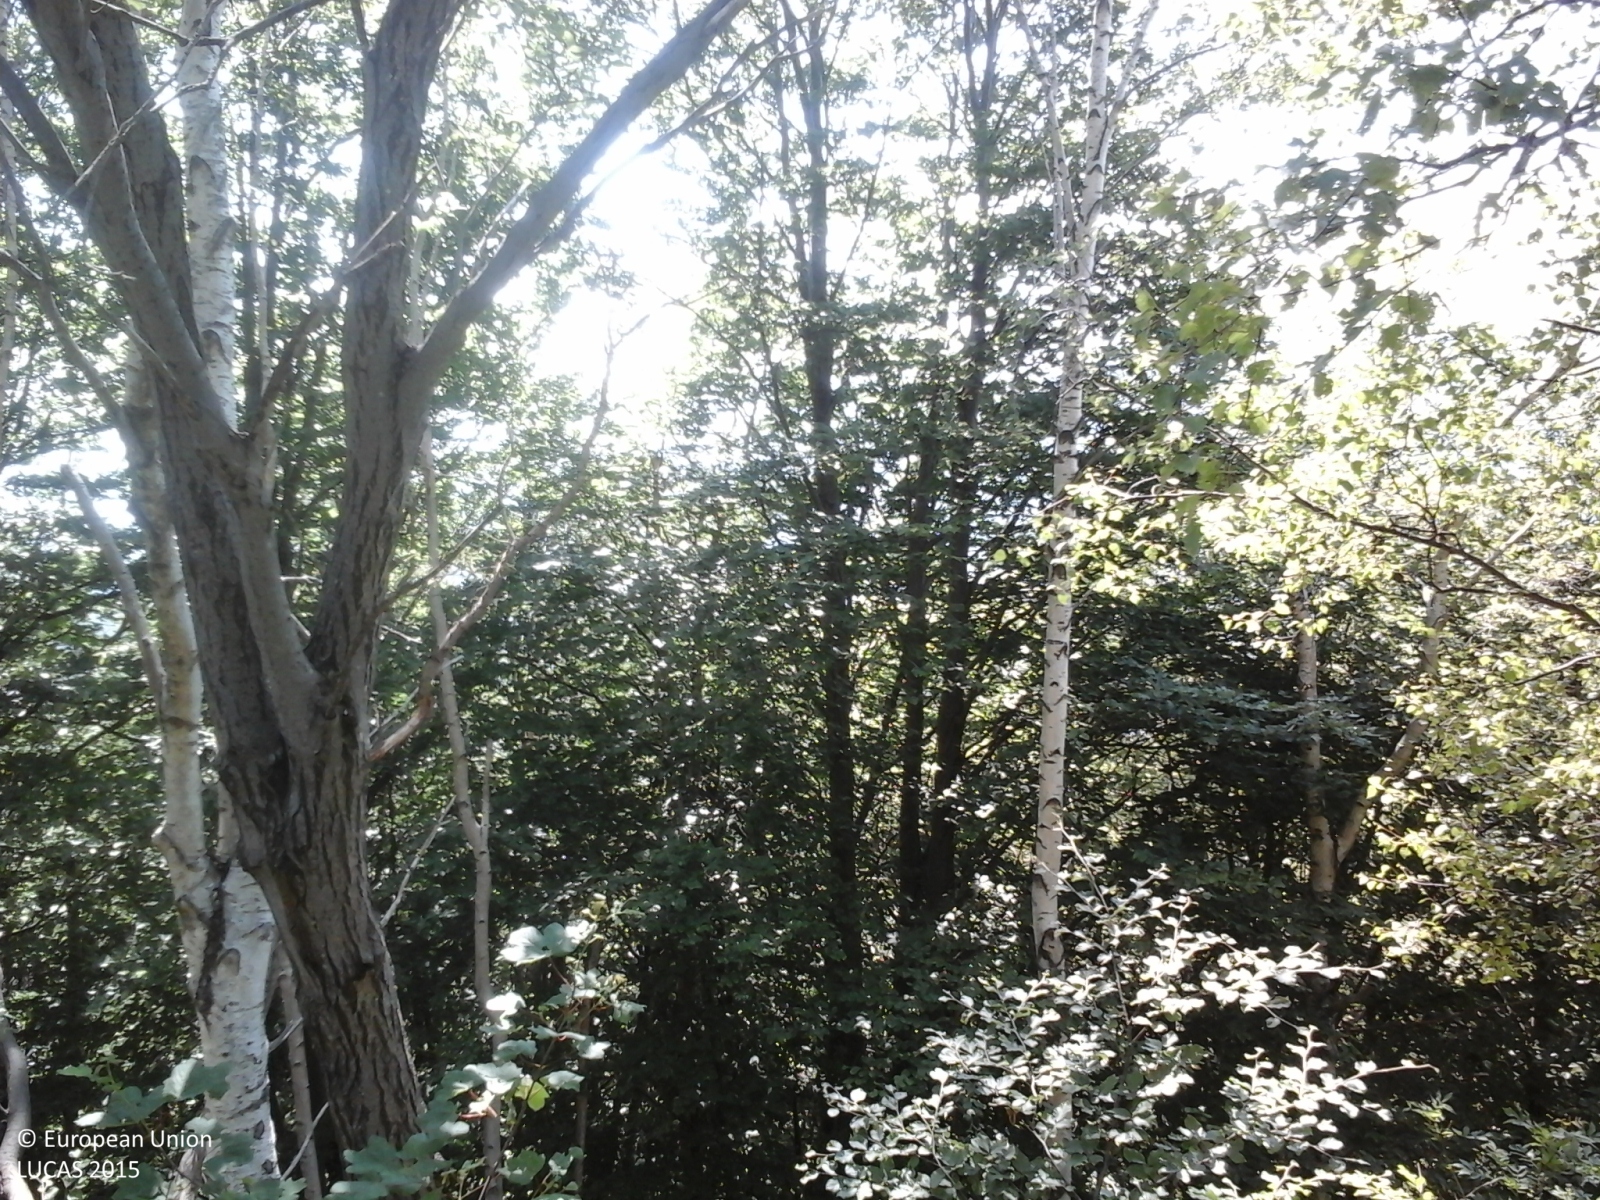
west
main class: Woodland
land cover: Broadleaved woodland
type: thermophilous deciduous forest
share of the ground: > 75 %
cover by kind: broadleaved forest trees 100 %
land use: Forestry
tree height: > 5 m
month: June
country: IT
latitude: 46.0180
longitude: 8.6199
